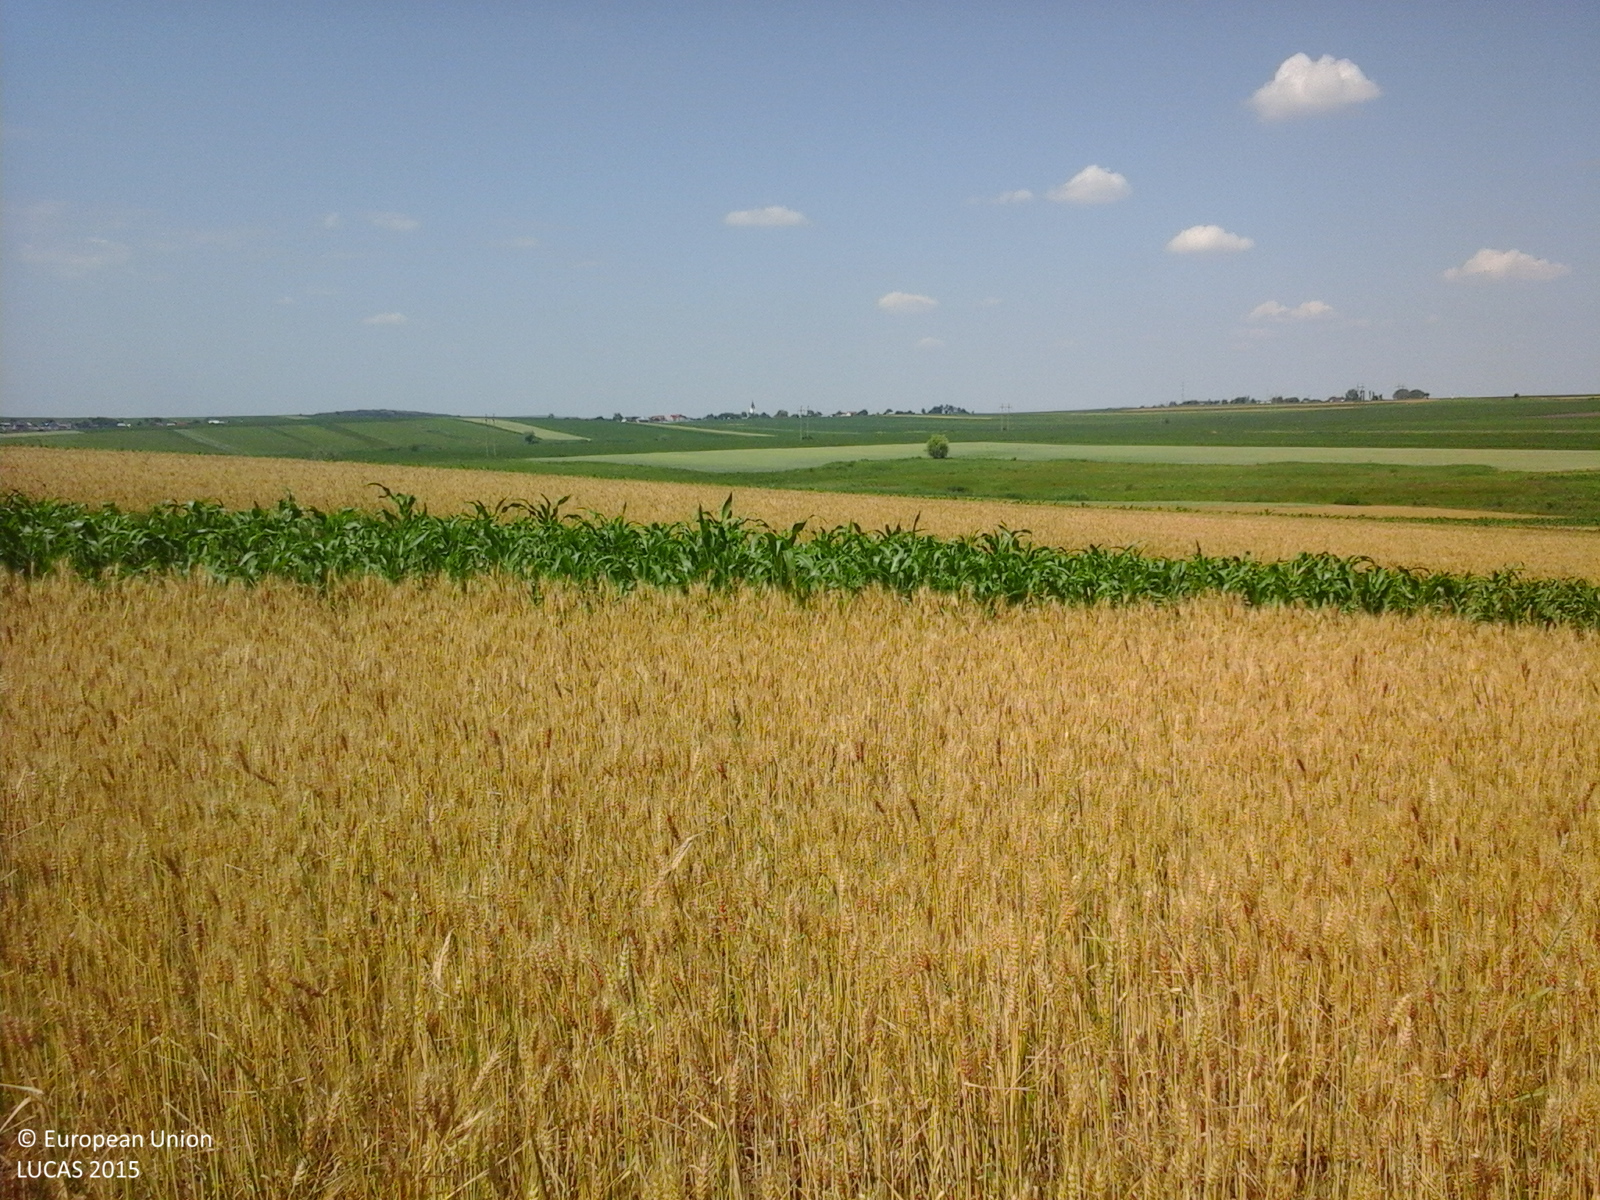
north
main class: Cropland
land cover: Common wheat
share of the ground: > 75 %
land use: Agriculture (excluding fallow land and kitchen gardens)
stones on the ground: 10 - 25 %
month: June
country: RO
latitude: 46.9965
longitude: 27.0247
